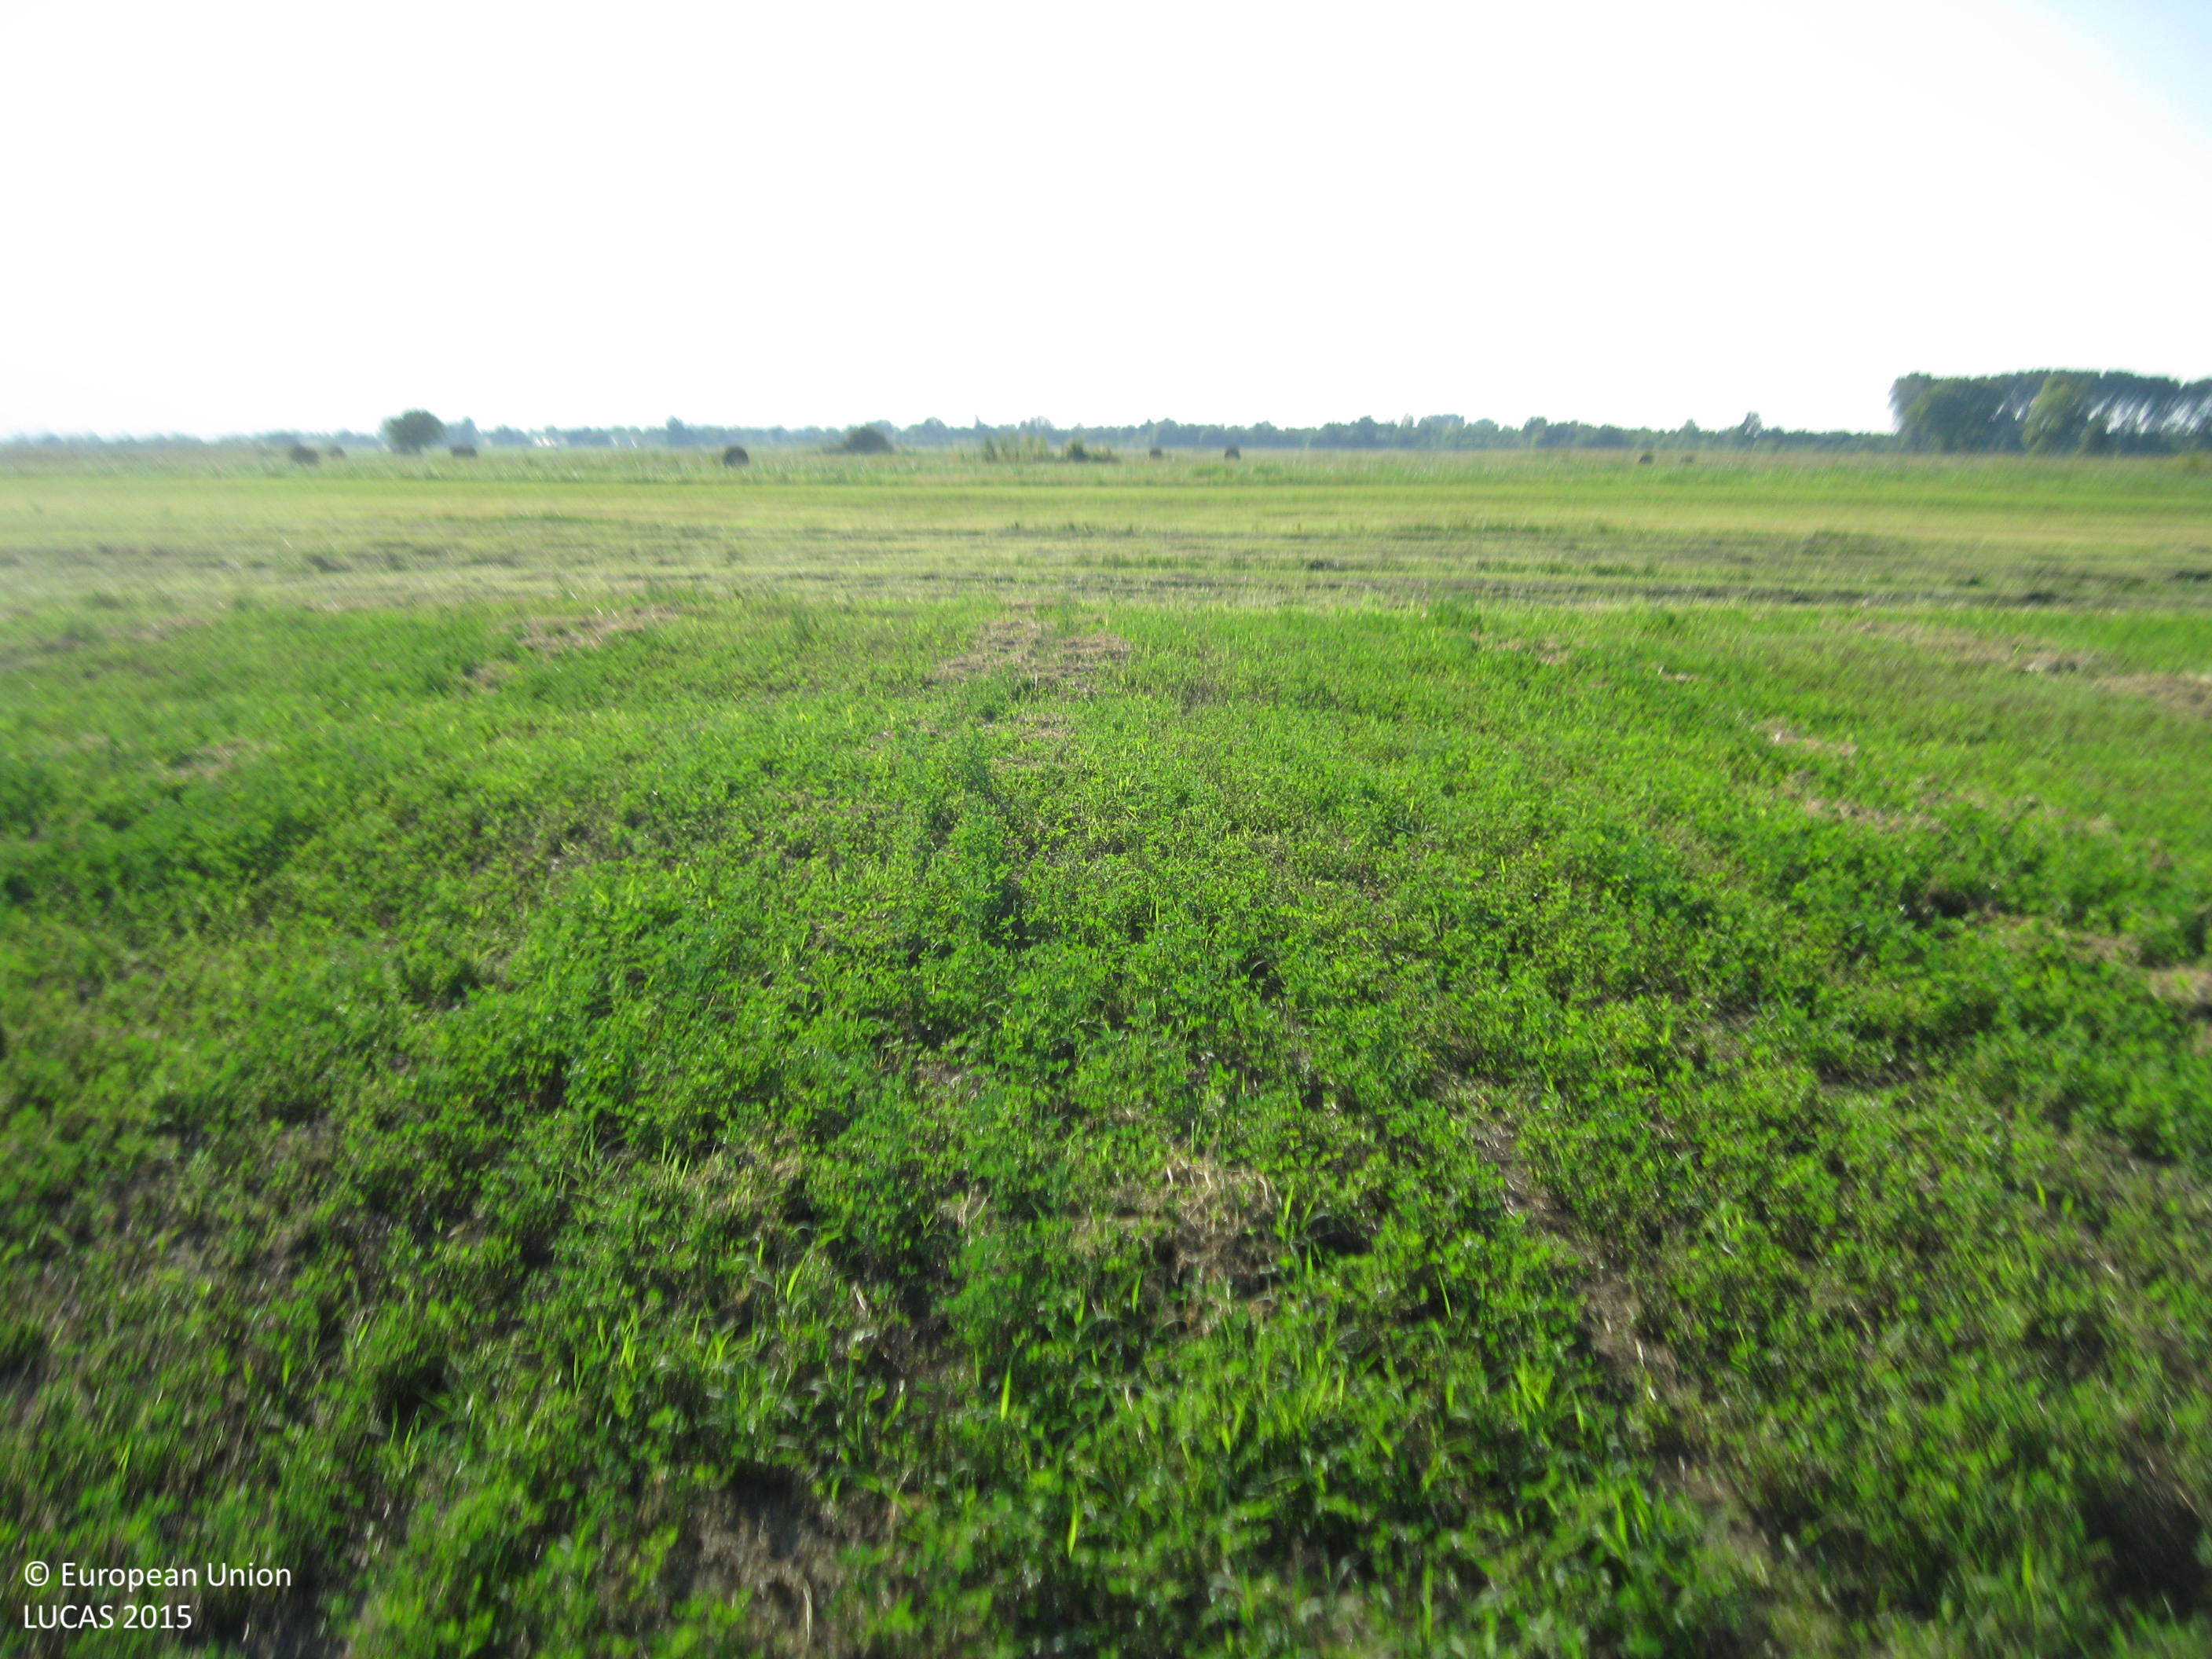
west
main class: Cropland
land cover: Lucerne
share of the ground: > 75 %
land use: Agriculture (excluding fallow land and kitchen gardens)
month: September
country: BG
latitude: 42.0504
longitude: 24.9515
